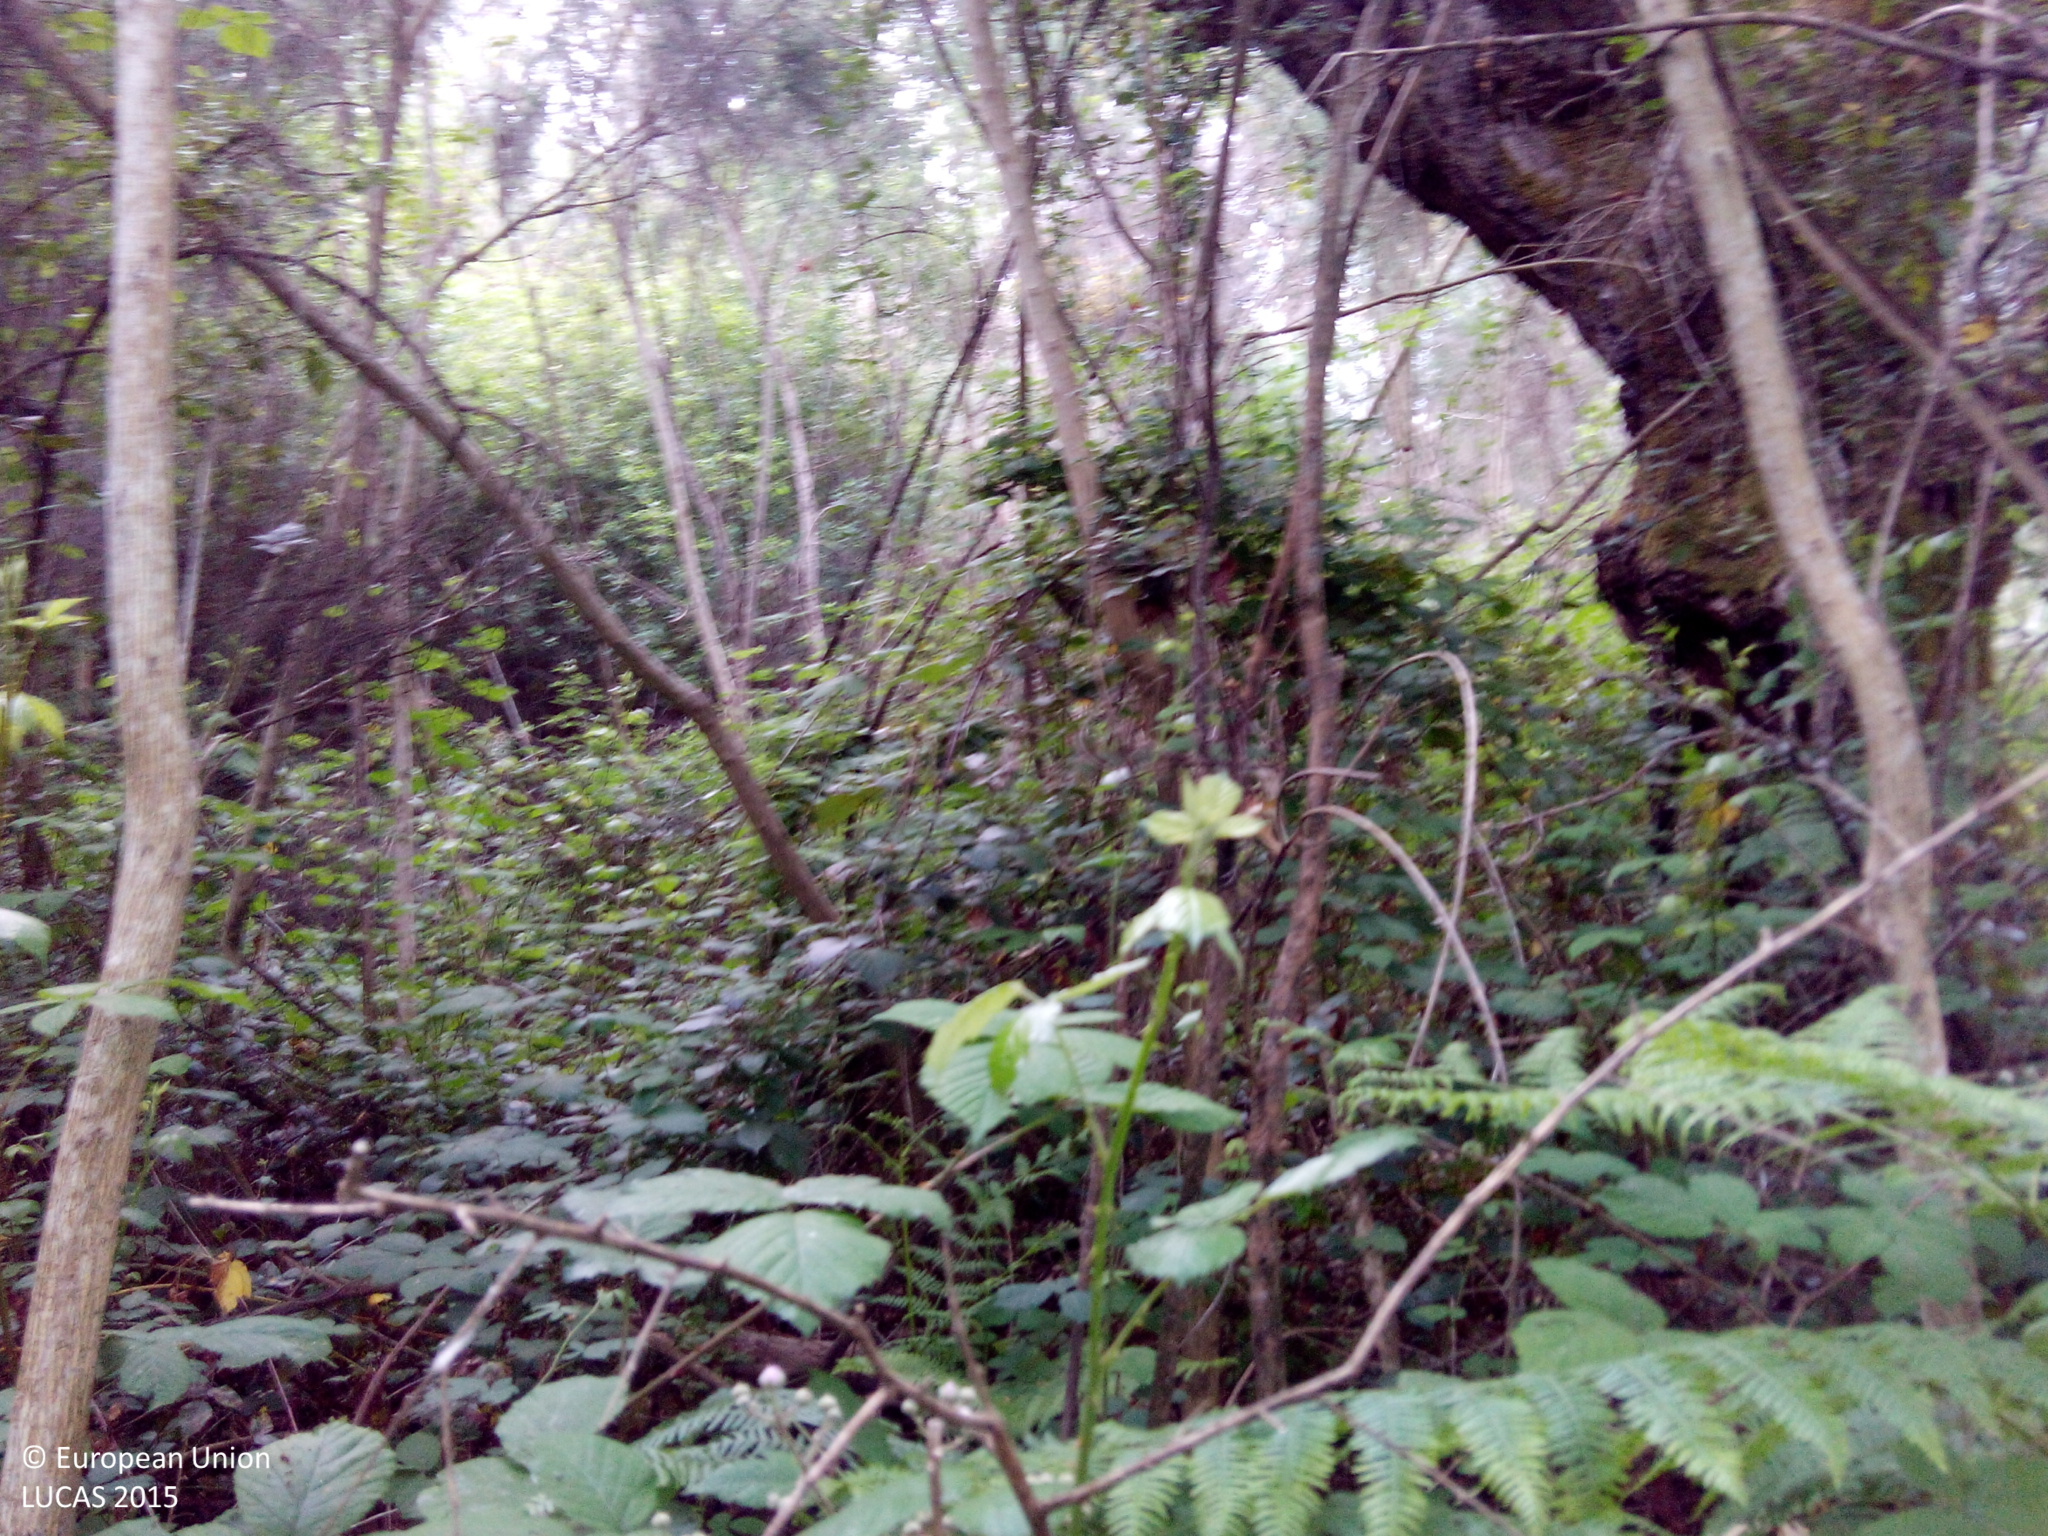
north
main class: Woodland
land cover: Broadleaved woodland
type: acidophilous oak and oak-birch forest
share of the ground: > 75 %
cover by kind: broadleaved forest trees 100 %
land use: Forestry
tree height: > 5 m
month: June
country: ES
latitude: 42.1476
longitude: -8.3237
